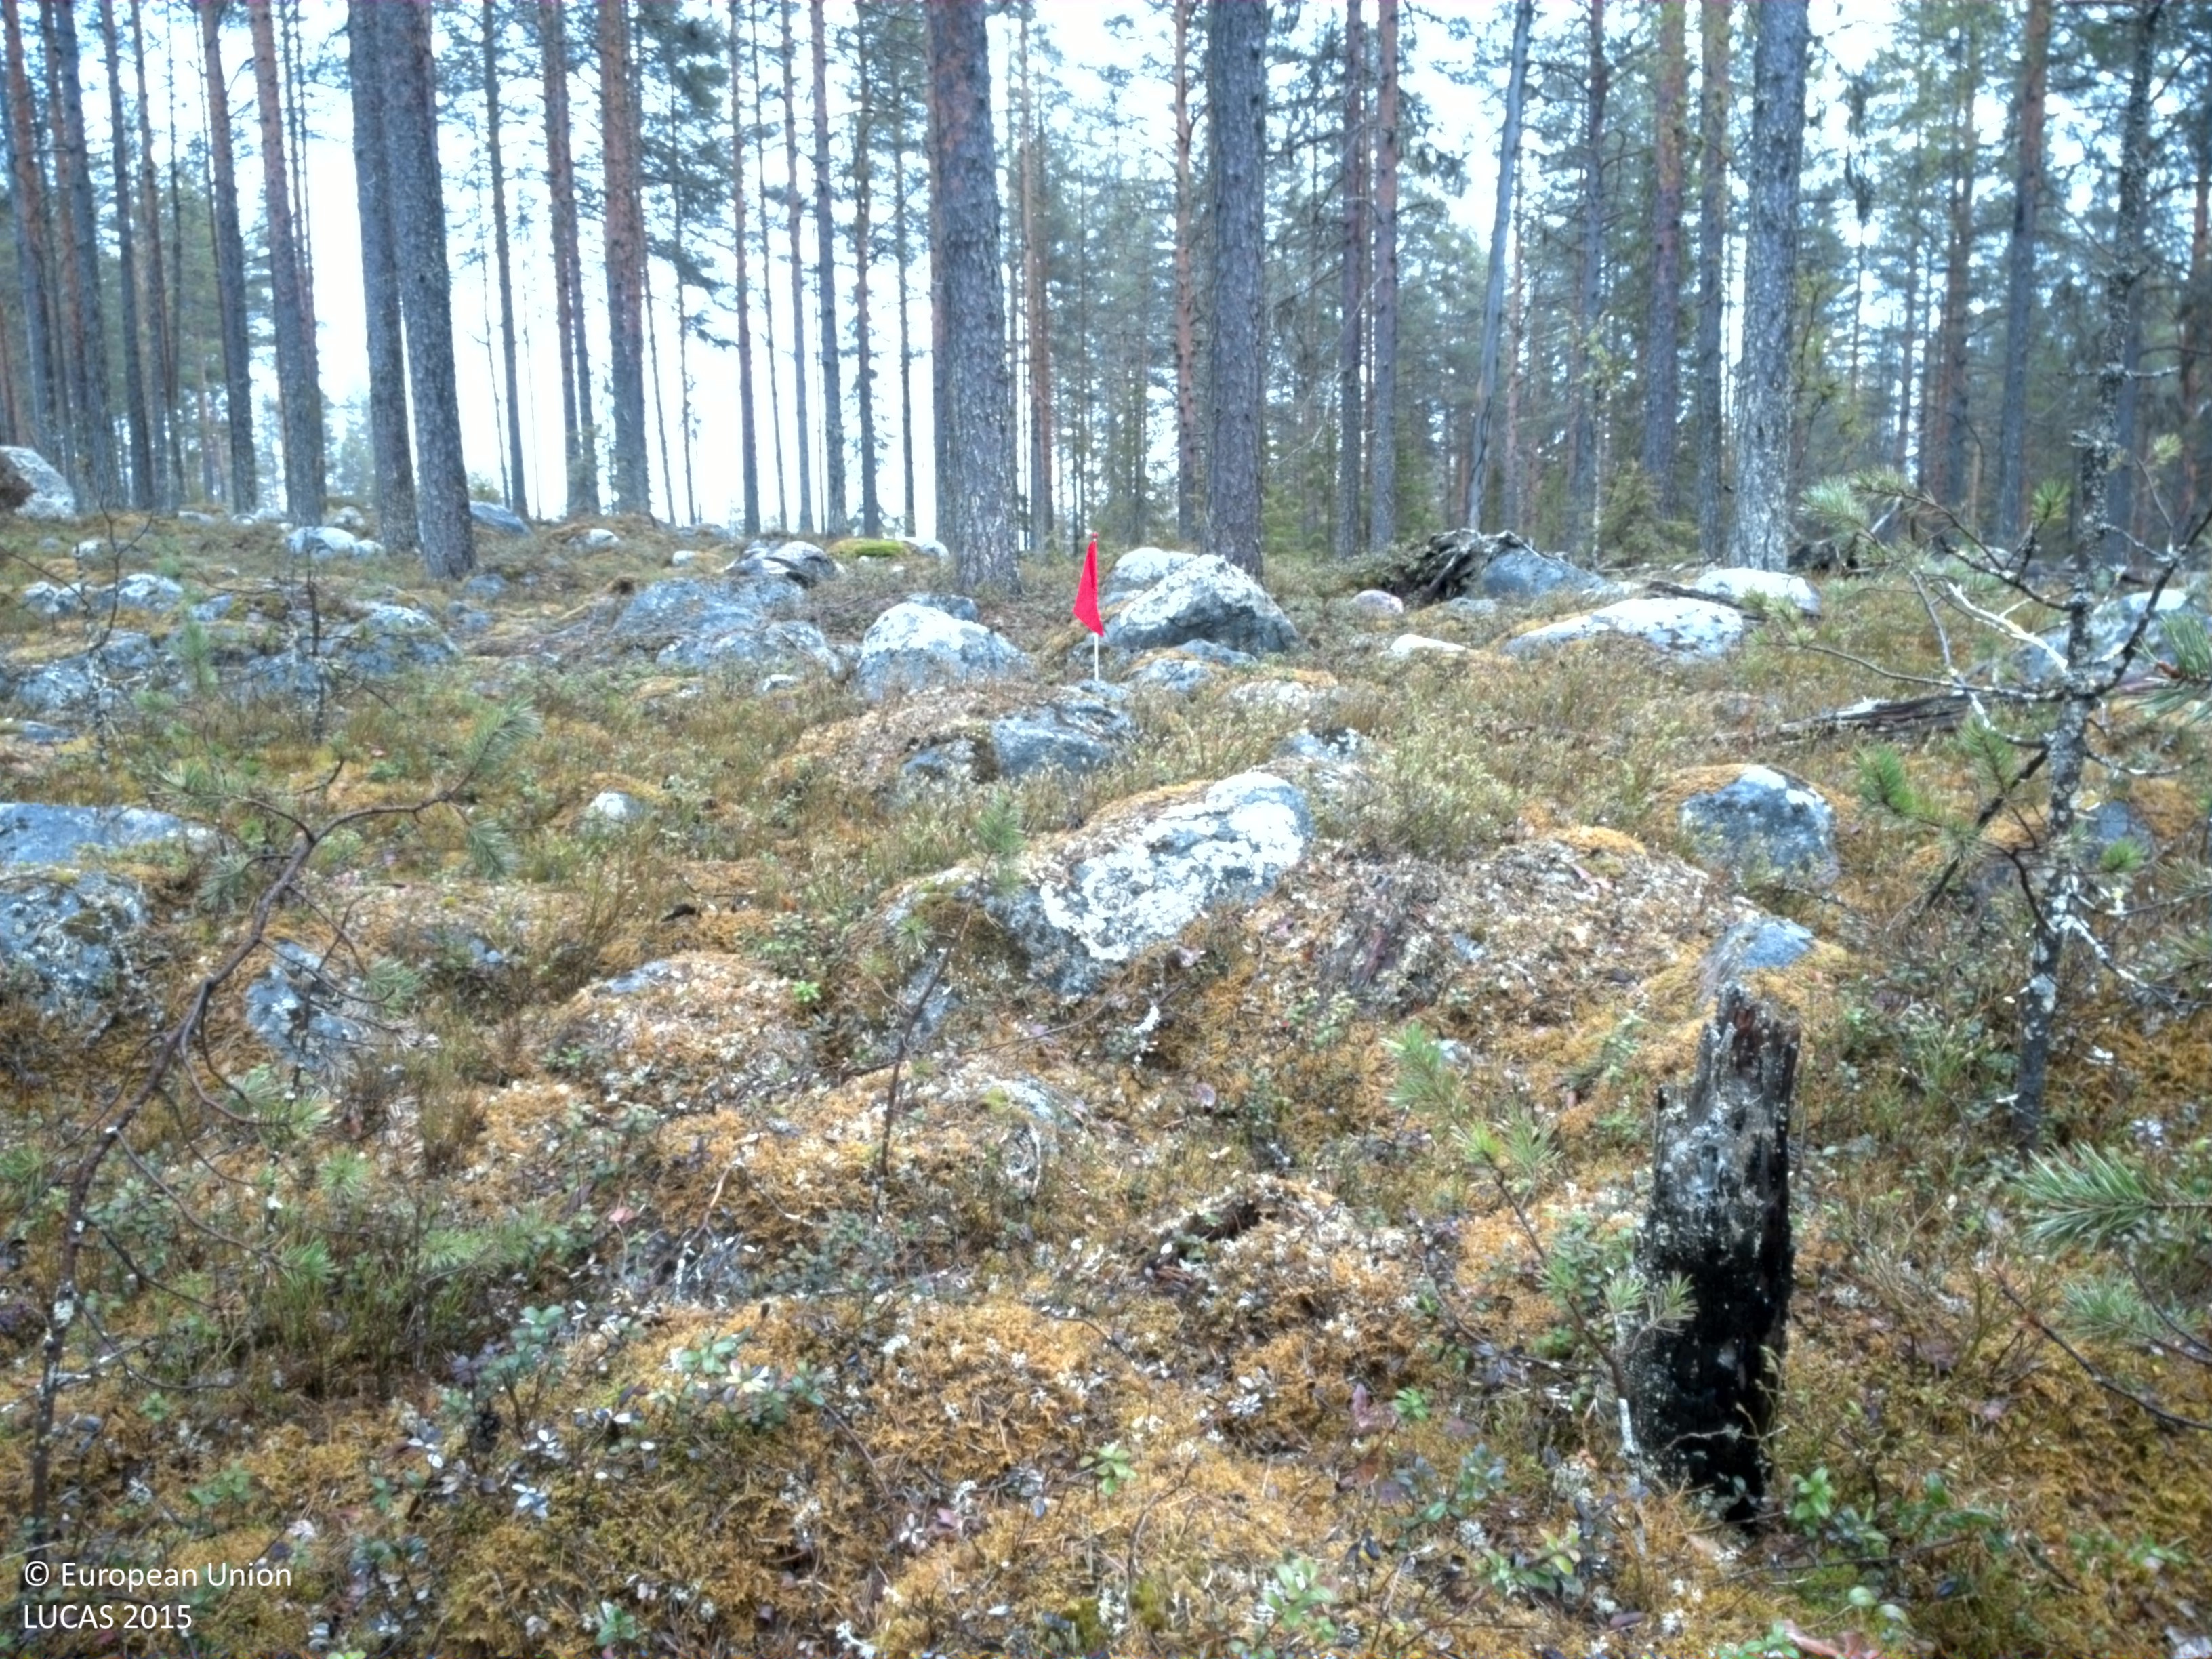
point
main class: Woodland
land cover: Pine dominated coniferous woodland
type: boreal forest
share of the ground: 50 - 75 %
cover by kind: coniferous forest trees 50 %, shrubs 25 %, consolidated bare surface 20 %, lichens and mosses 5 %
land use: Forestry
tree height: > 5 m
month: May
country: SE
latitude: 66.0837
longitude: 23.0034
